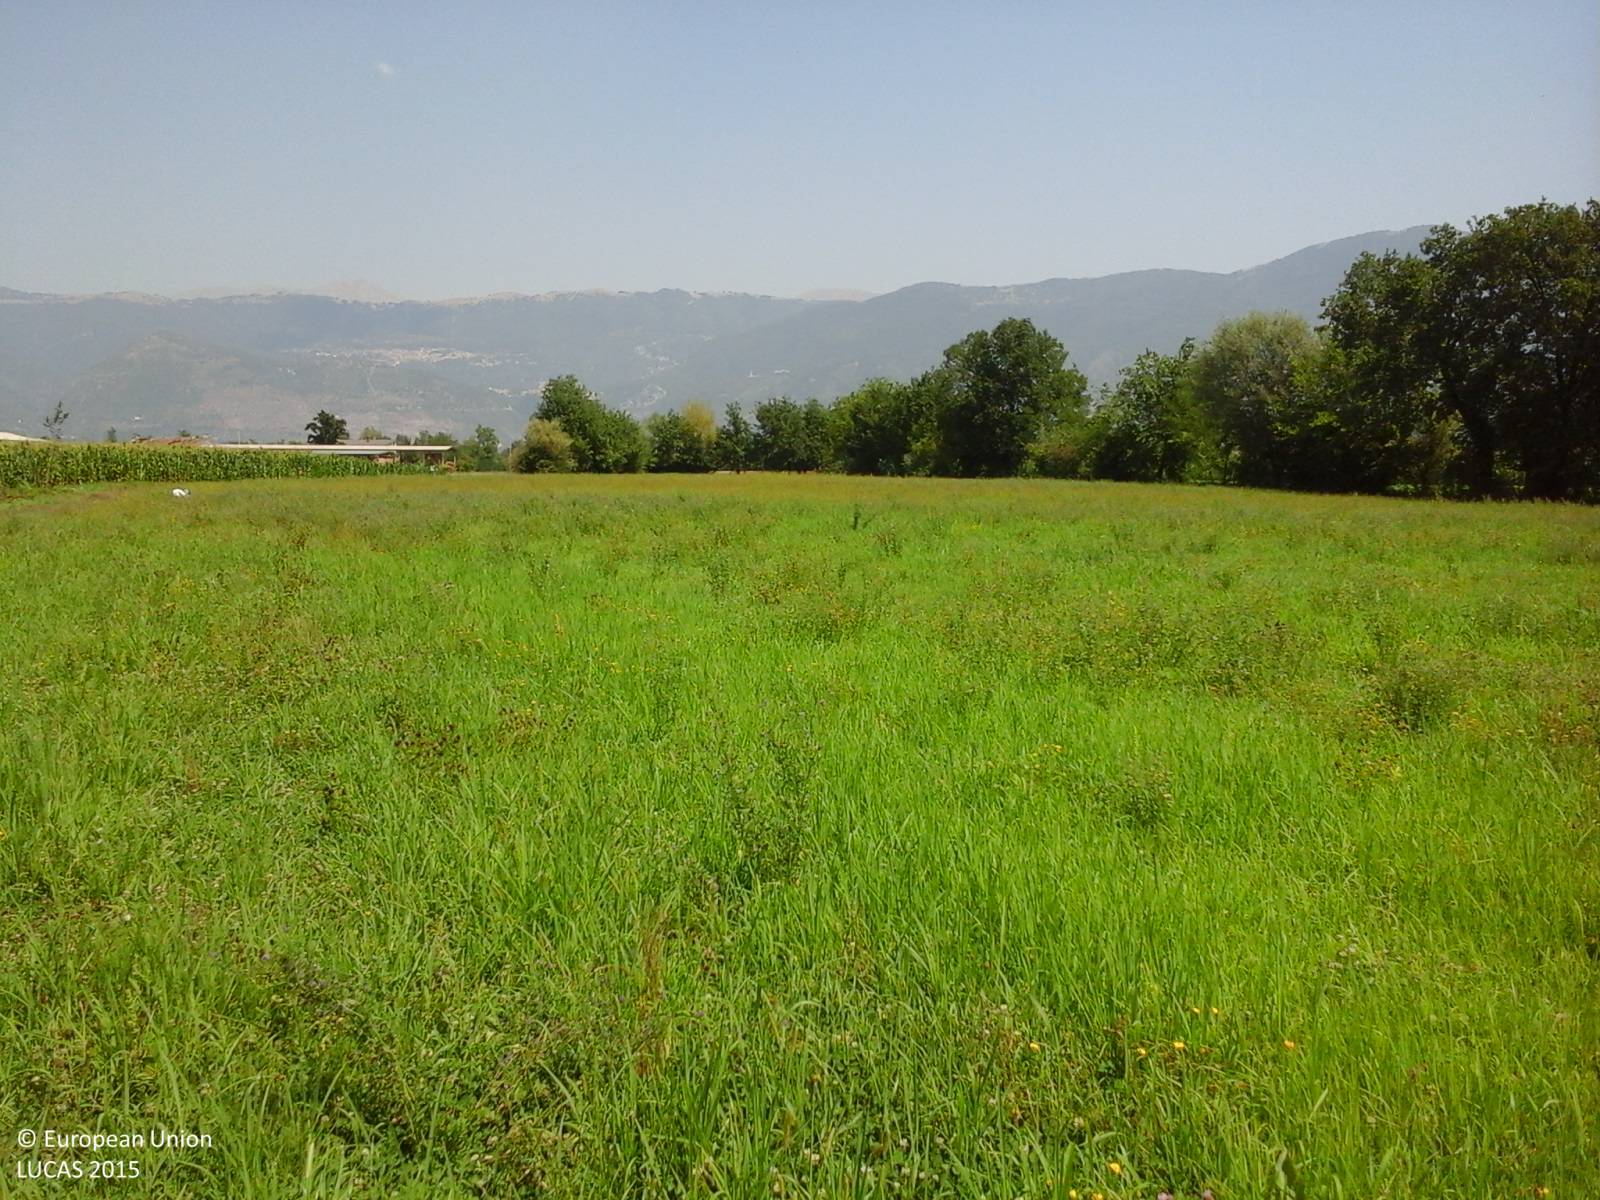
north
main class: Cropland
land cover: Temporary grasslands
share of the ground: > 75 %
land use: Agriculture (excluding fallow land and kitchen gardens)
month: August
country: IT
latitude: 41.3113
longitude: 14.3673
